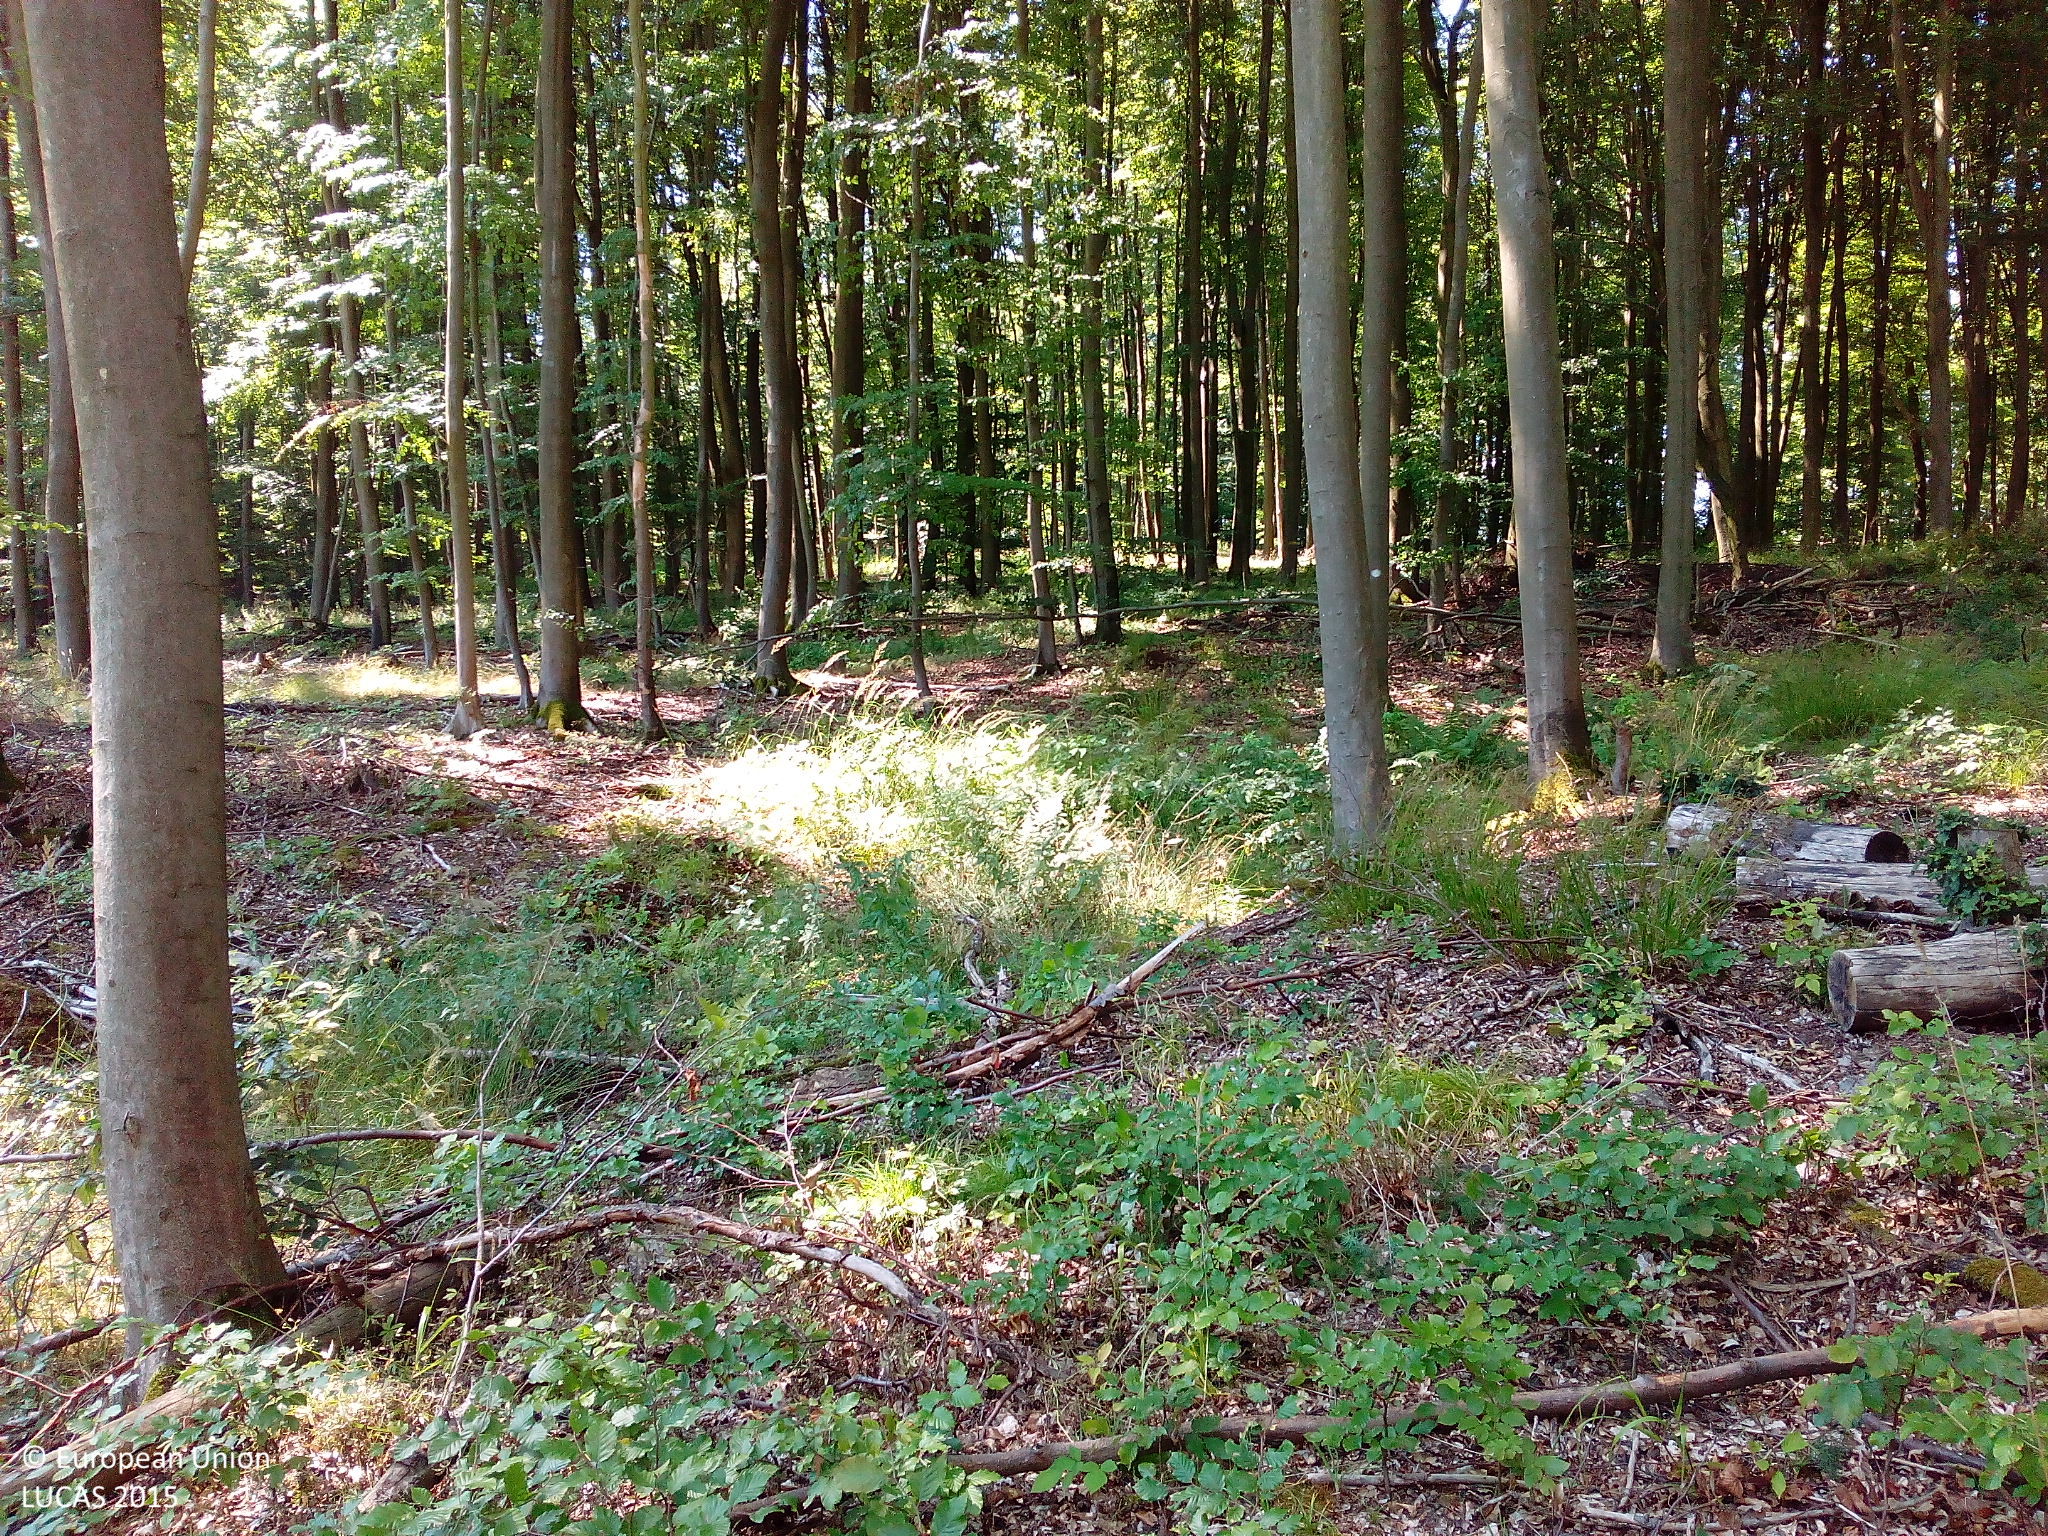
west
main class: Woodland
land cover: Broadleaved woodland
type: beech forest
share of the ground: > 75 %
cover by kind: broadleaved forest trees 90 %, herbaceous plants 5 %, unconsolidated bare surface 5 %
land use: Forestry
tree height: > 5 m
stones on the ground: < 10 %
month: August
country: DE
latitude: 50.7397
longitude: 9.3342
